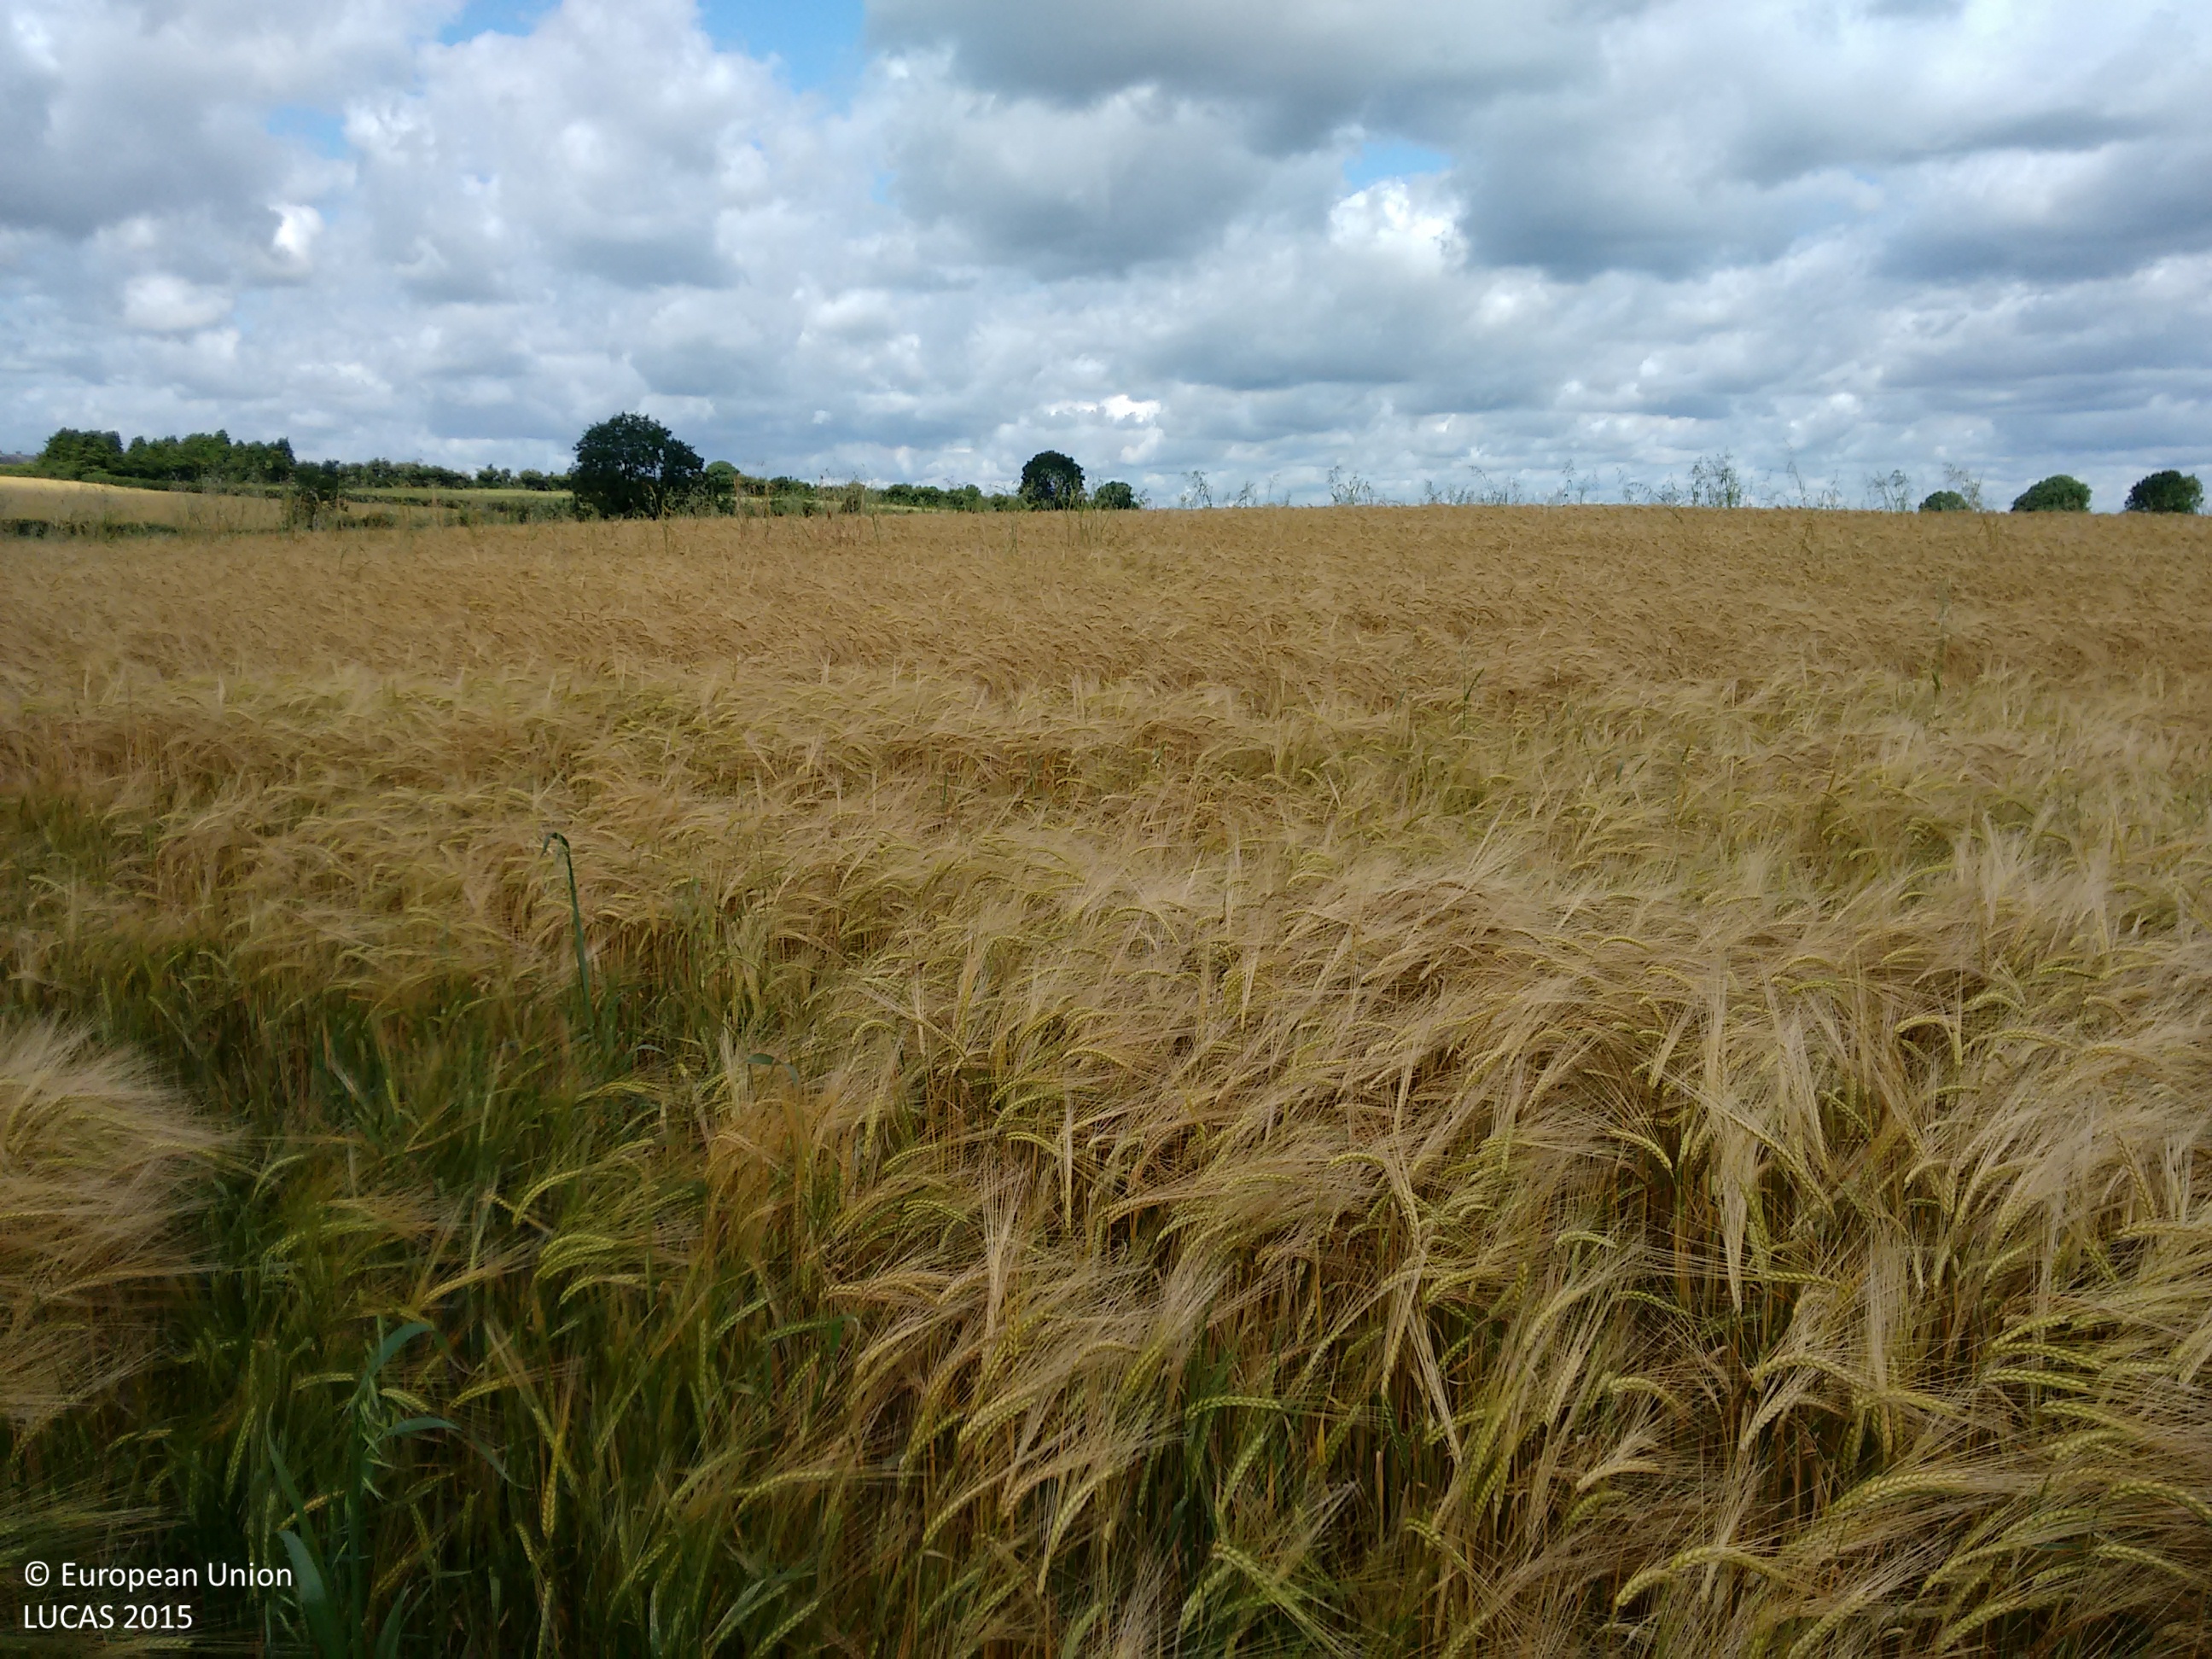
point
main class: Cropland
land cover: Triticale
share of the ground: > 75 %
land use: Agriculture (excluding fallow land and kitchen gardens)
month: July
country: IE
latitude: 52.6477
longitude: -7.6185
